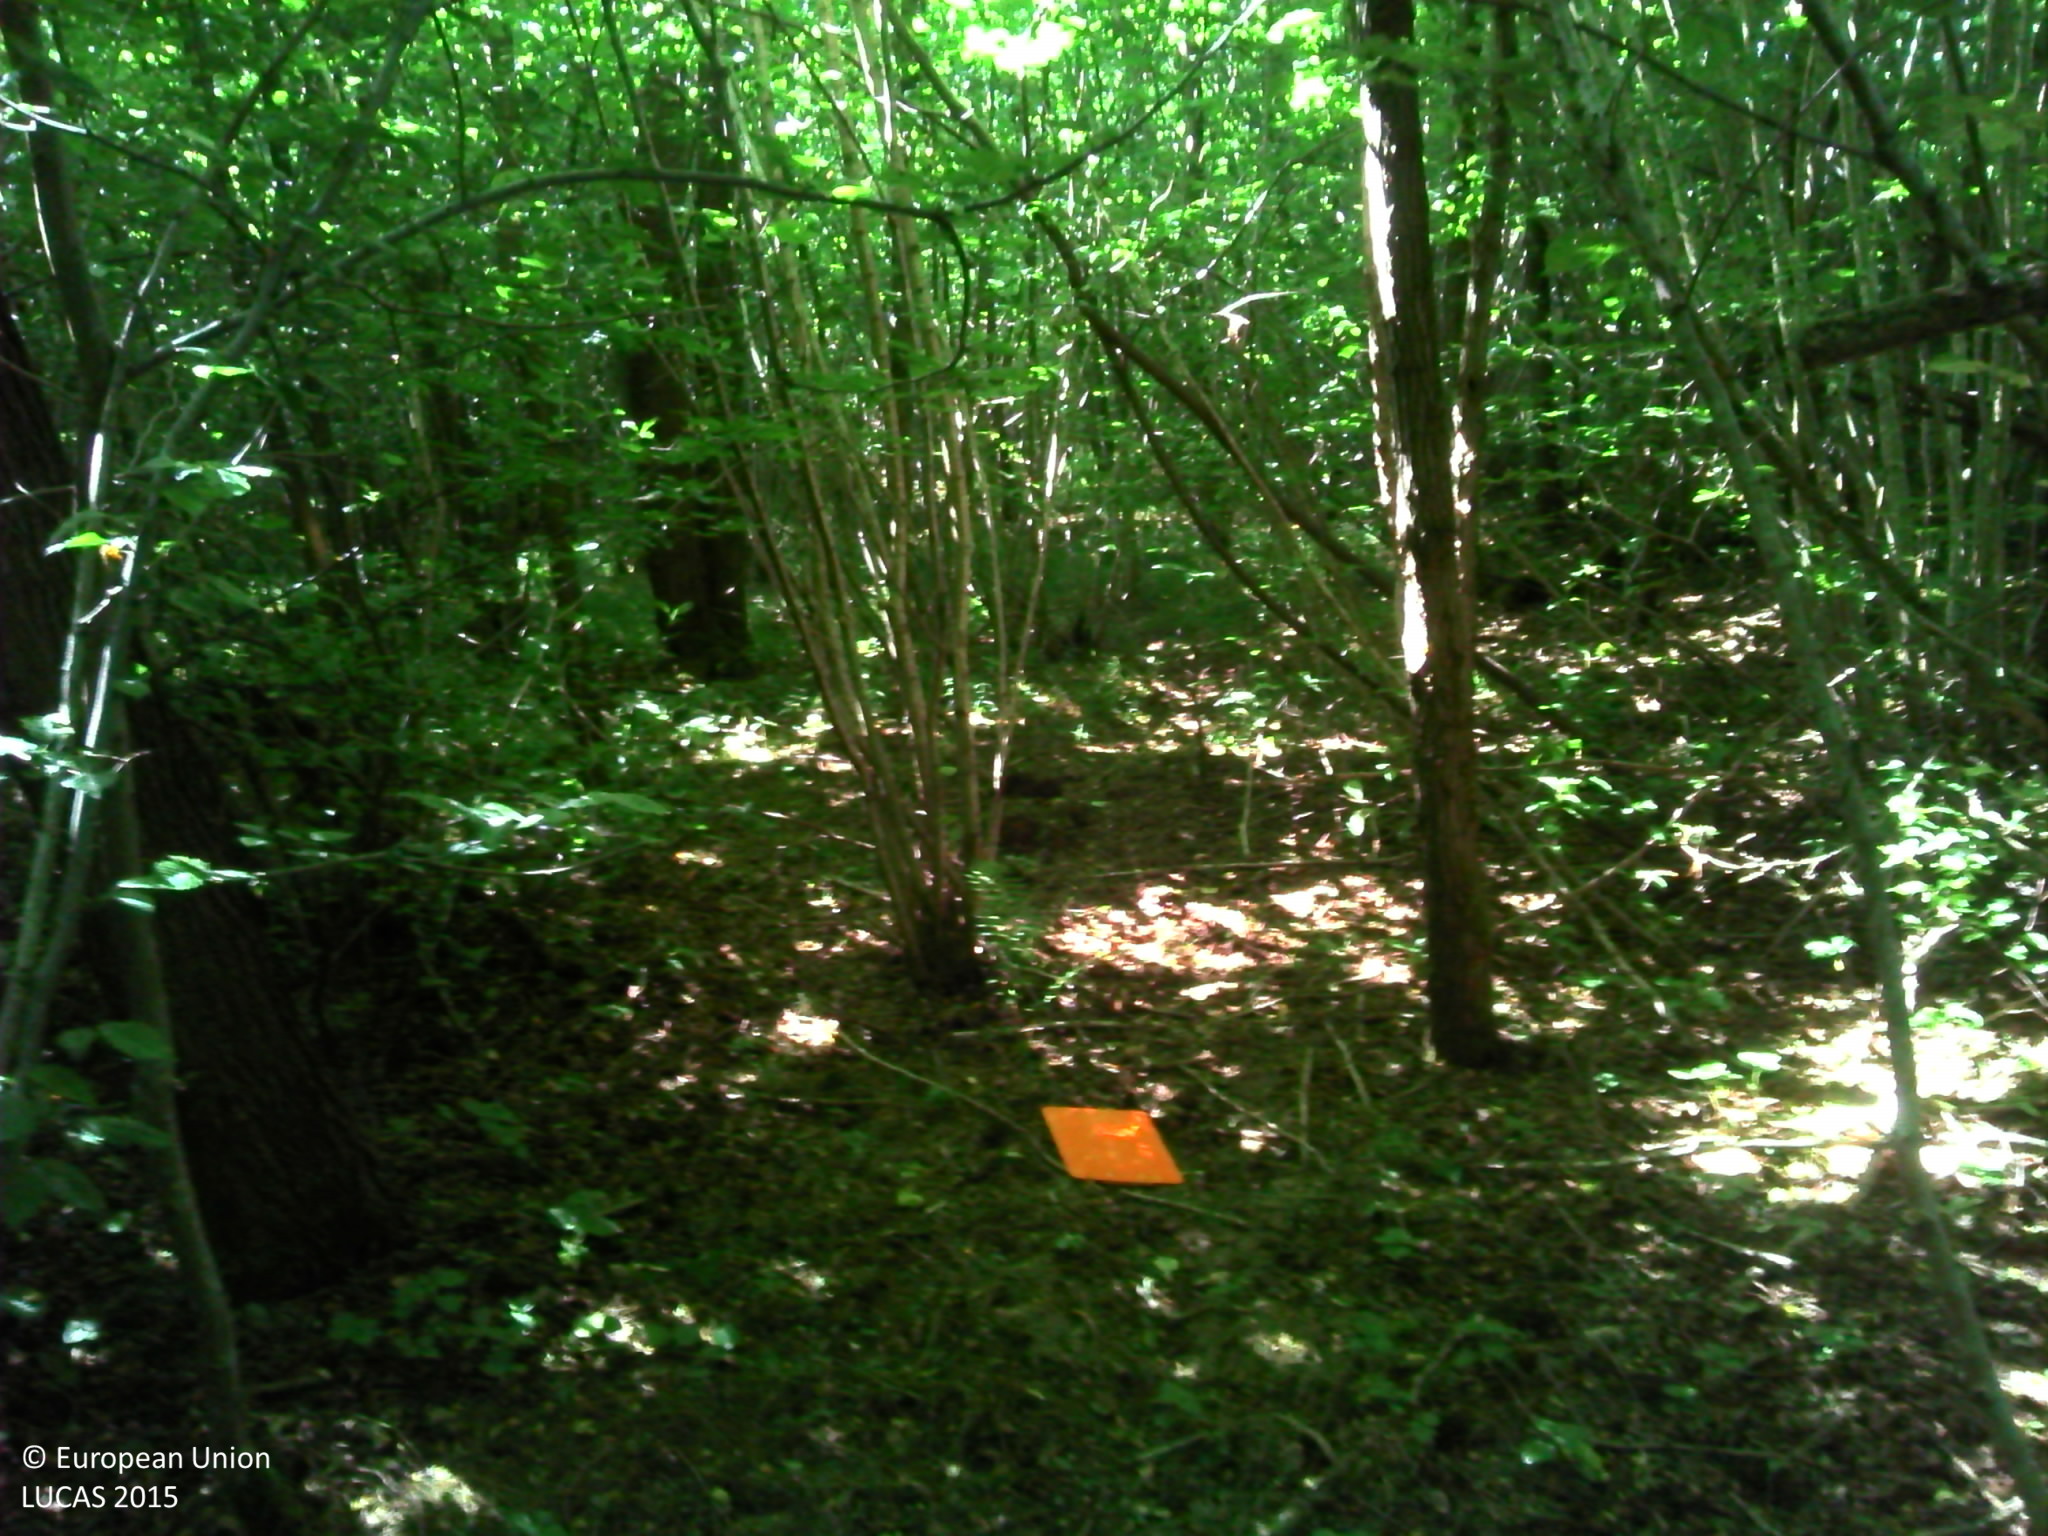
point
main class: Woodland
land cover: Broadleaved woodland
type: mesophytic deciduous forest
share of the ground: > 75 %
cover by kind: broadleaved forest trees 90 %, herbaceous plants 5 %, lichens and mosses 5 %
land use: Forestry
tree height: > 5 m
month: July
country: FR
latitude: 48.4320
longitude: 6.3106
